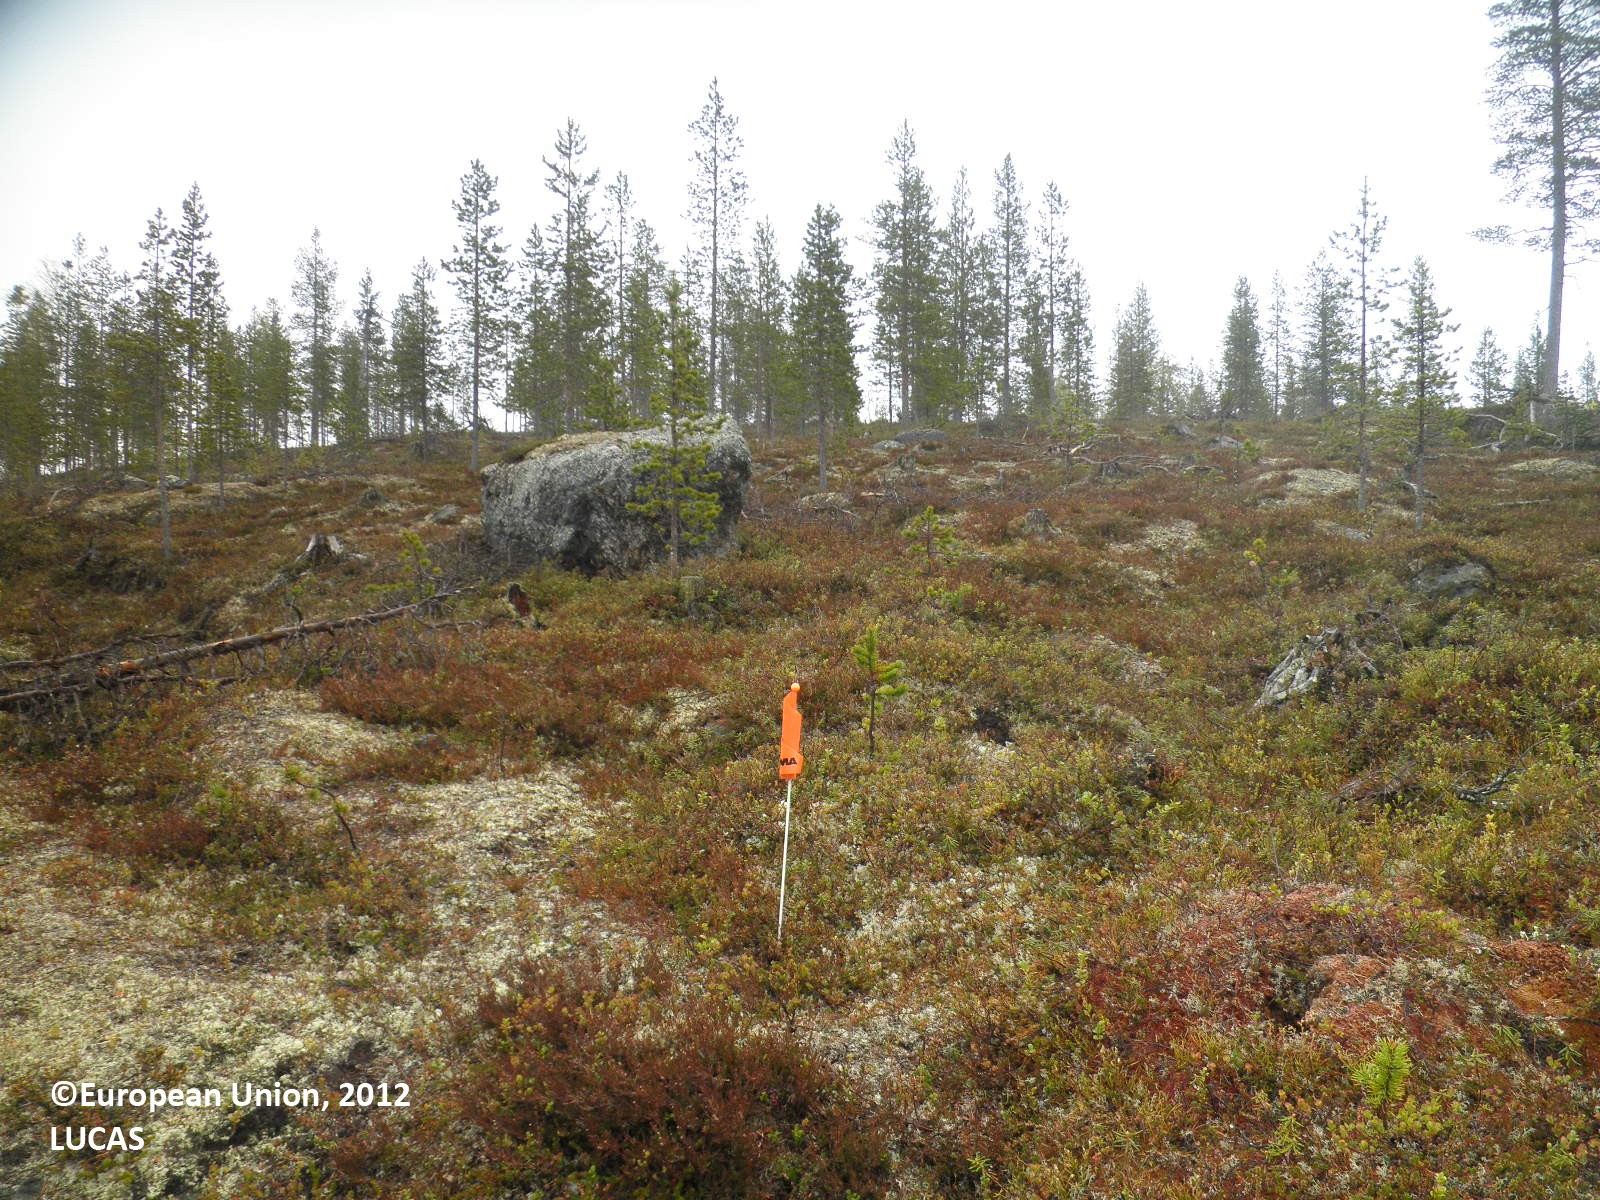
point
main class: Woodland
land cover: Pine dominated coniferous woodland
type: boreal forest
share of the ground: 10 - 25 %
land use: Forestry
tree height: > 5 m
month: June
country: FI
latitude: 69.0809
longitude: 27.2018
